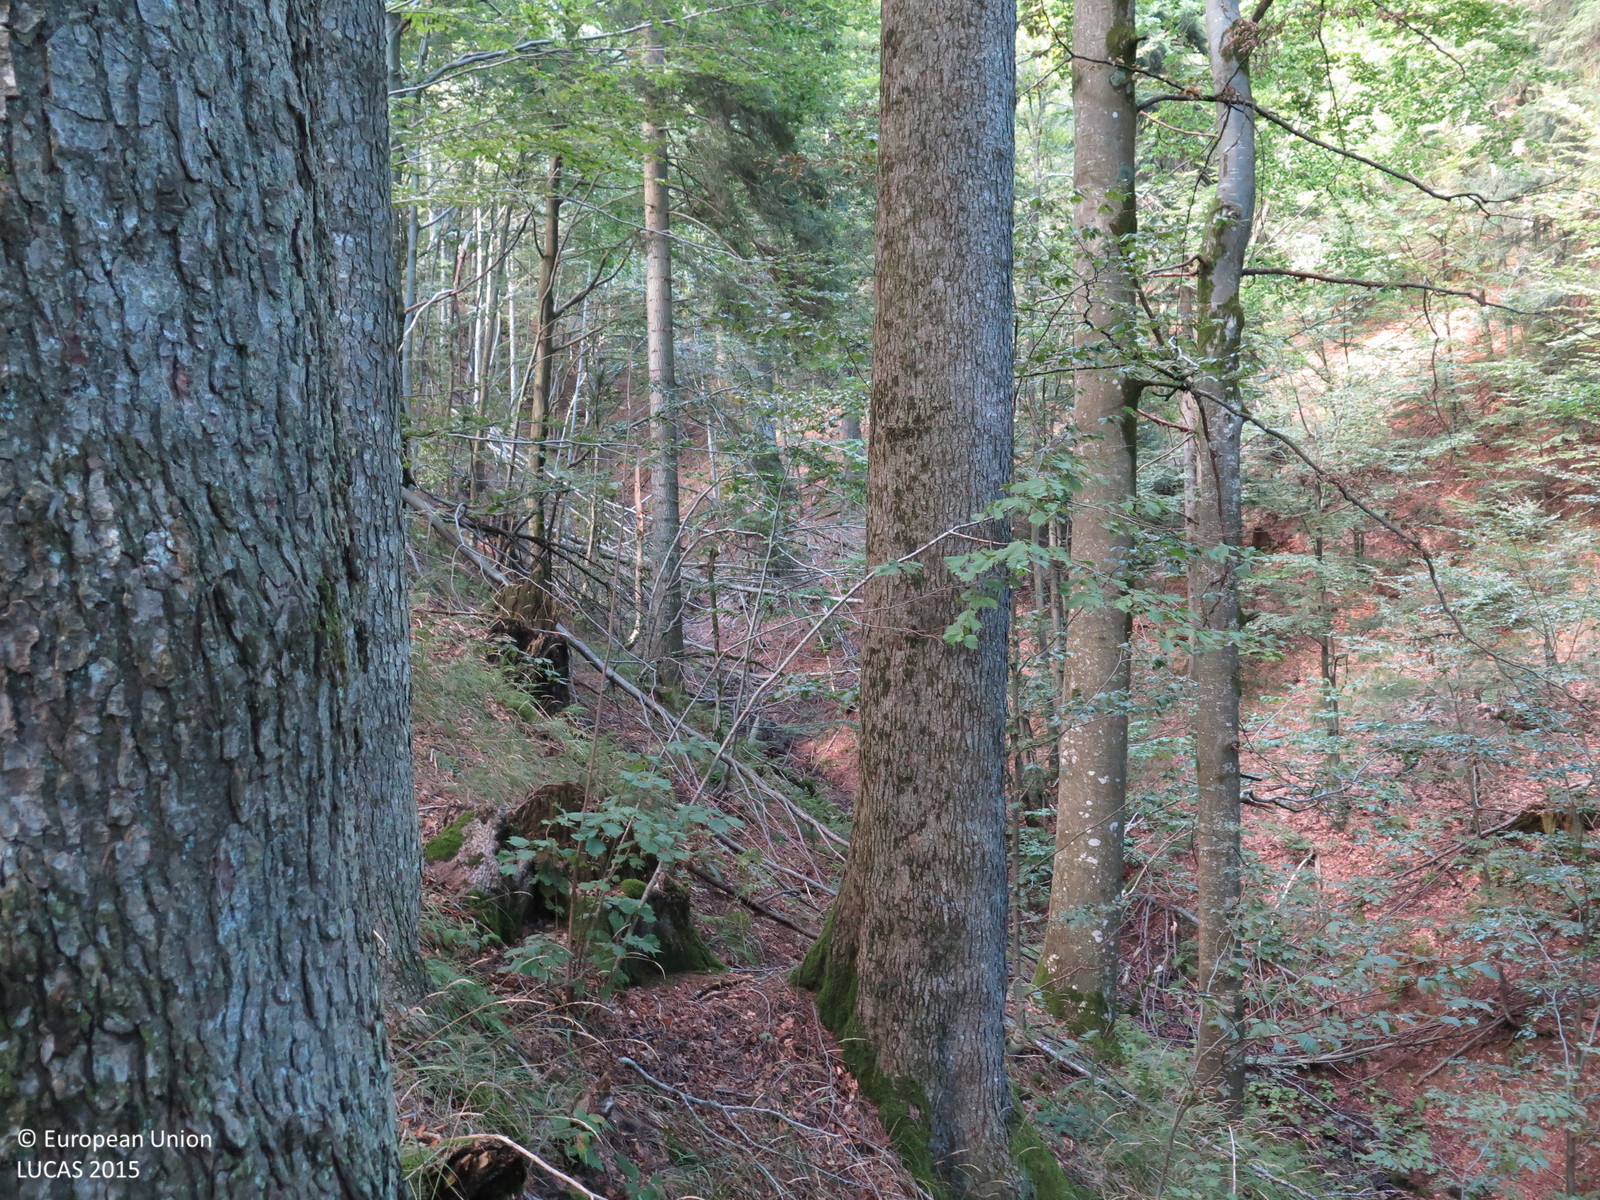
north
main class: Woodland
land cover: Other mixed woodland
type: mountainous beech forest
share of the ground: > 75 %
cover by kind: broadleaved forest trees 75 %, coniferous forest trees 25 %
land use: Forestry
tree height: > 5 m
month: September
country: HR
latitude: 45.4701
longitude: 14.7408
